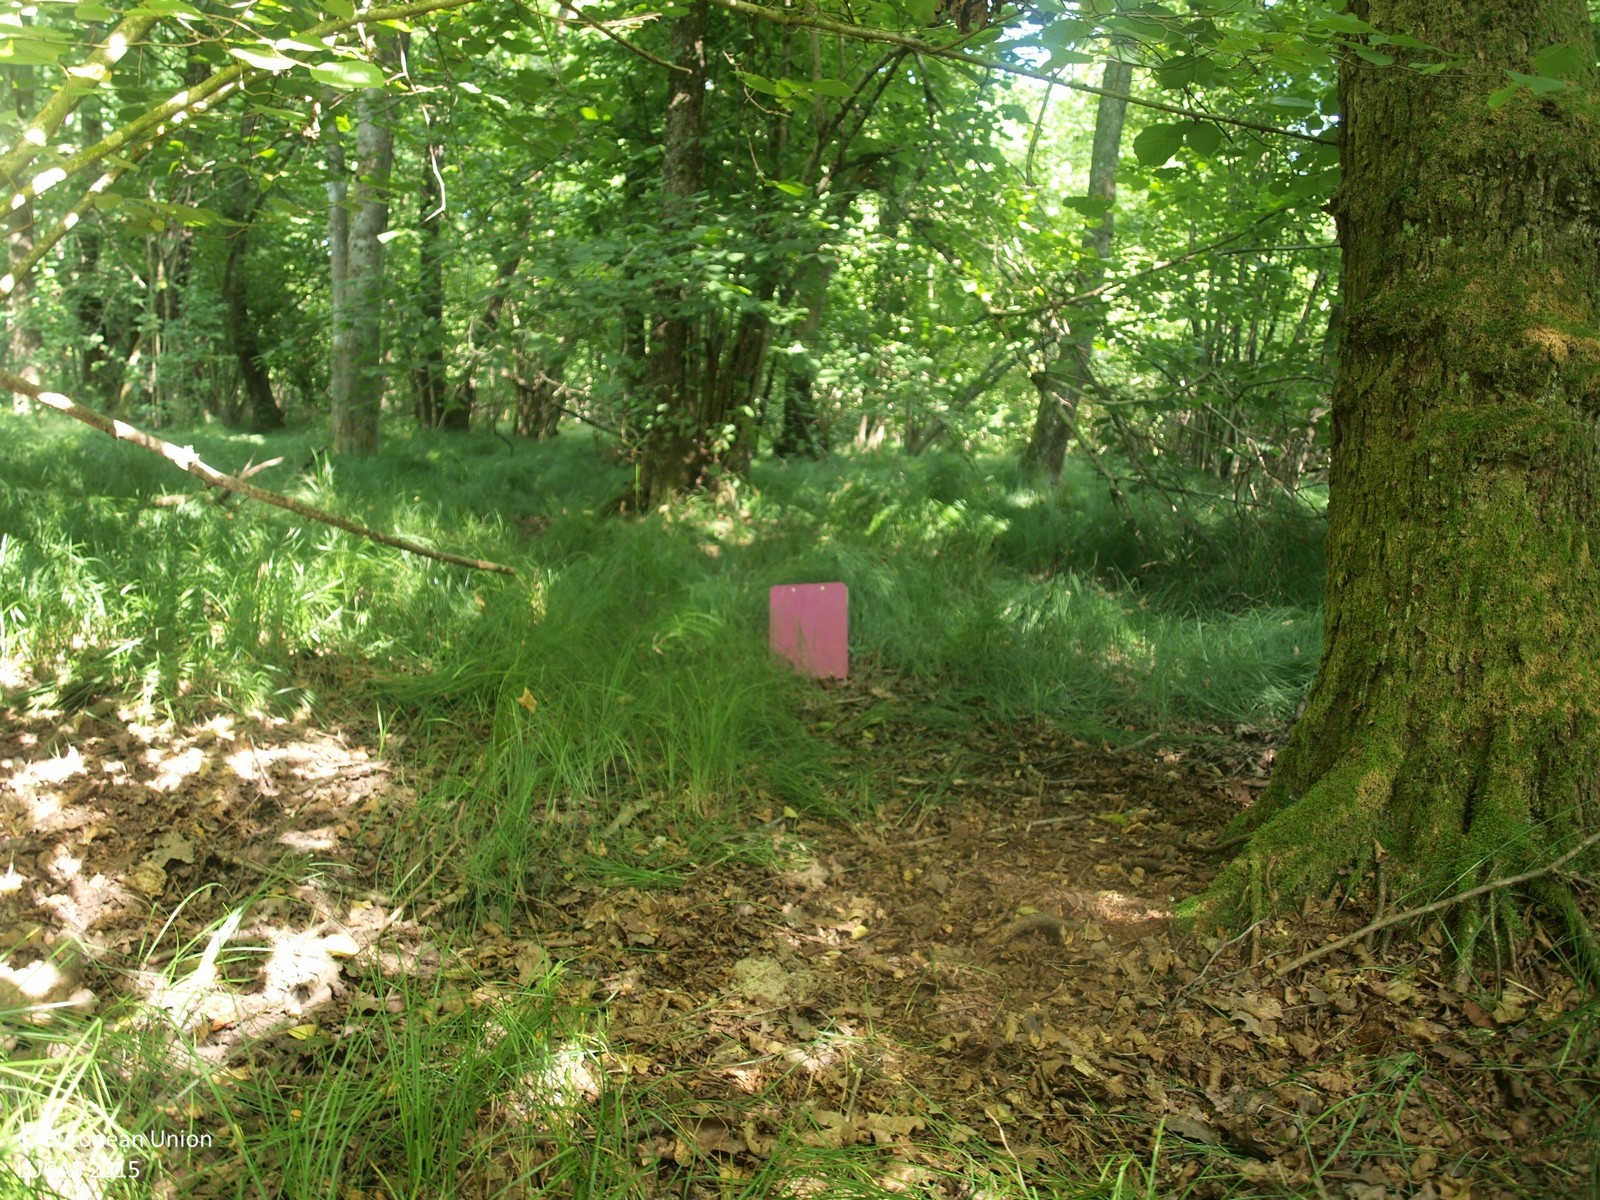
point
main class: Woodland
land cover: Broadleaved woodland
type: floodplain forest
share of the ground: > 75 %
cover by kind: broadleaved forest trees 100 %
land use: Forestry
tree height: > 5 m
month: July
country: HR
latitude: 45.6571
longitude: 15.7078
